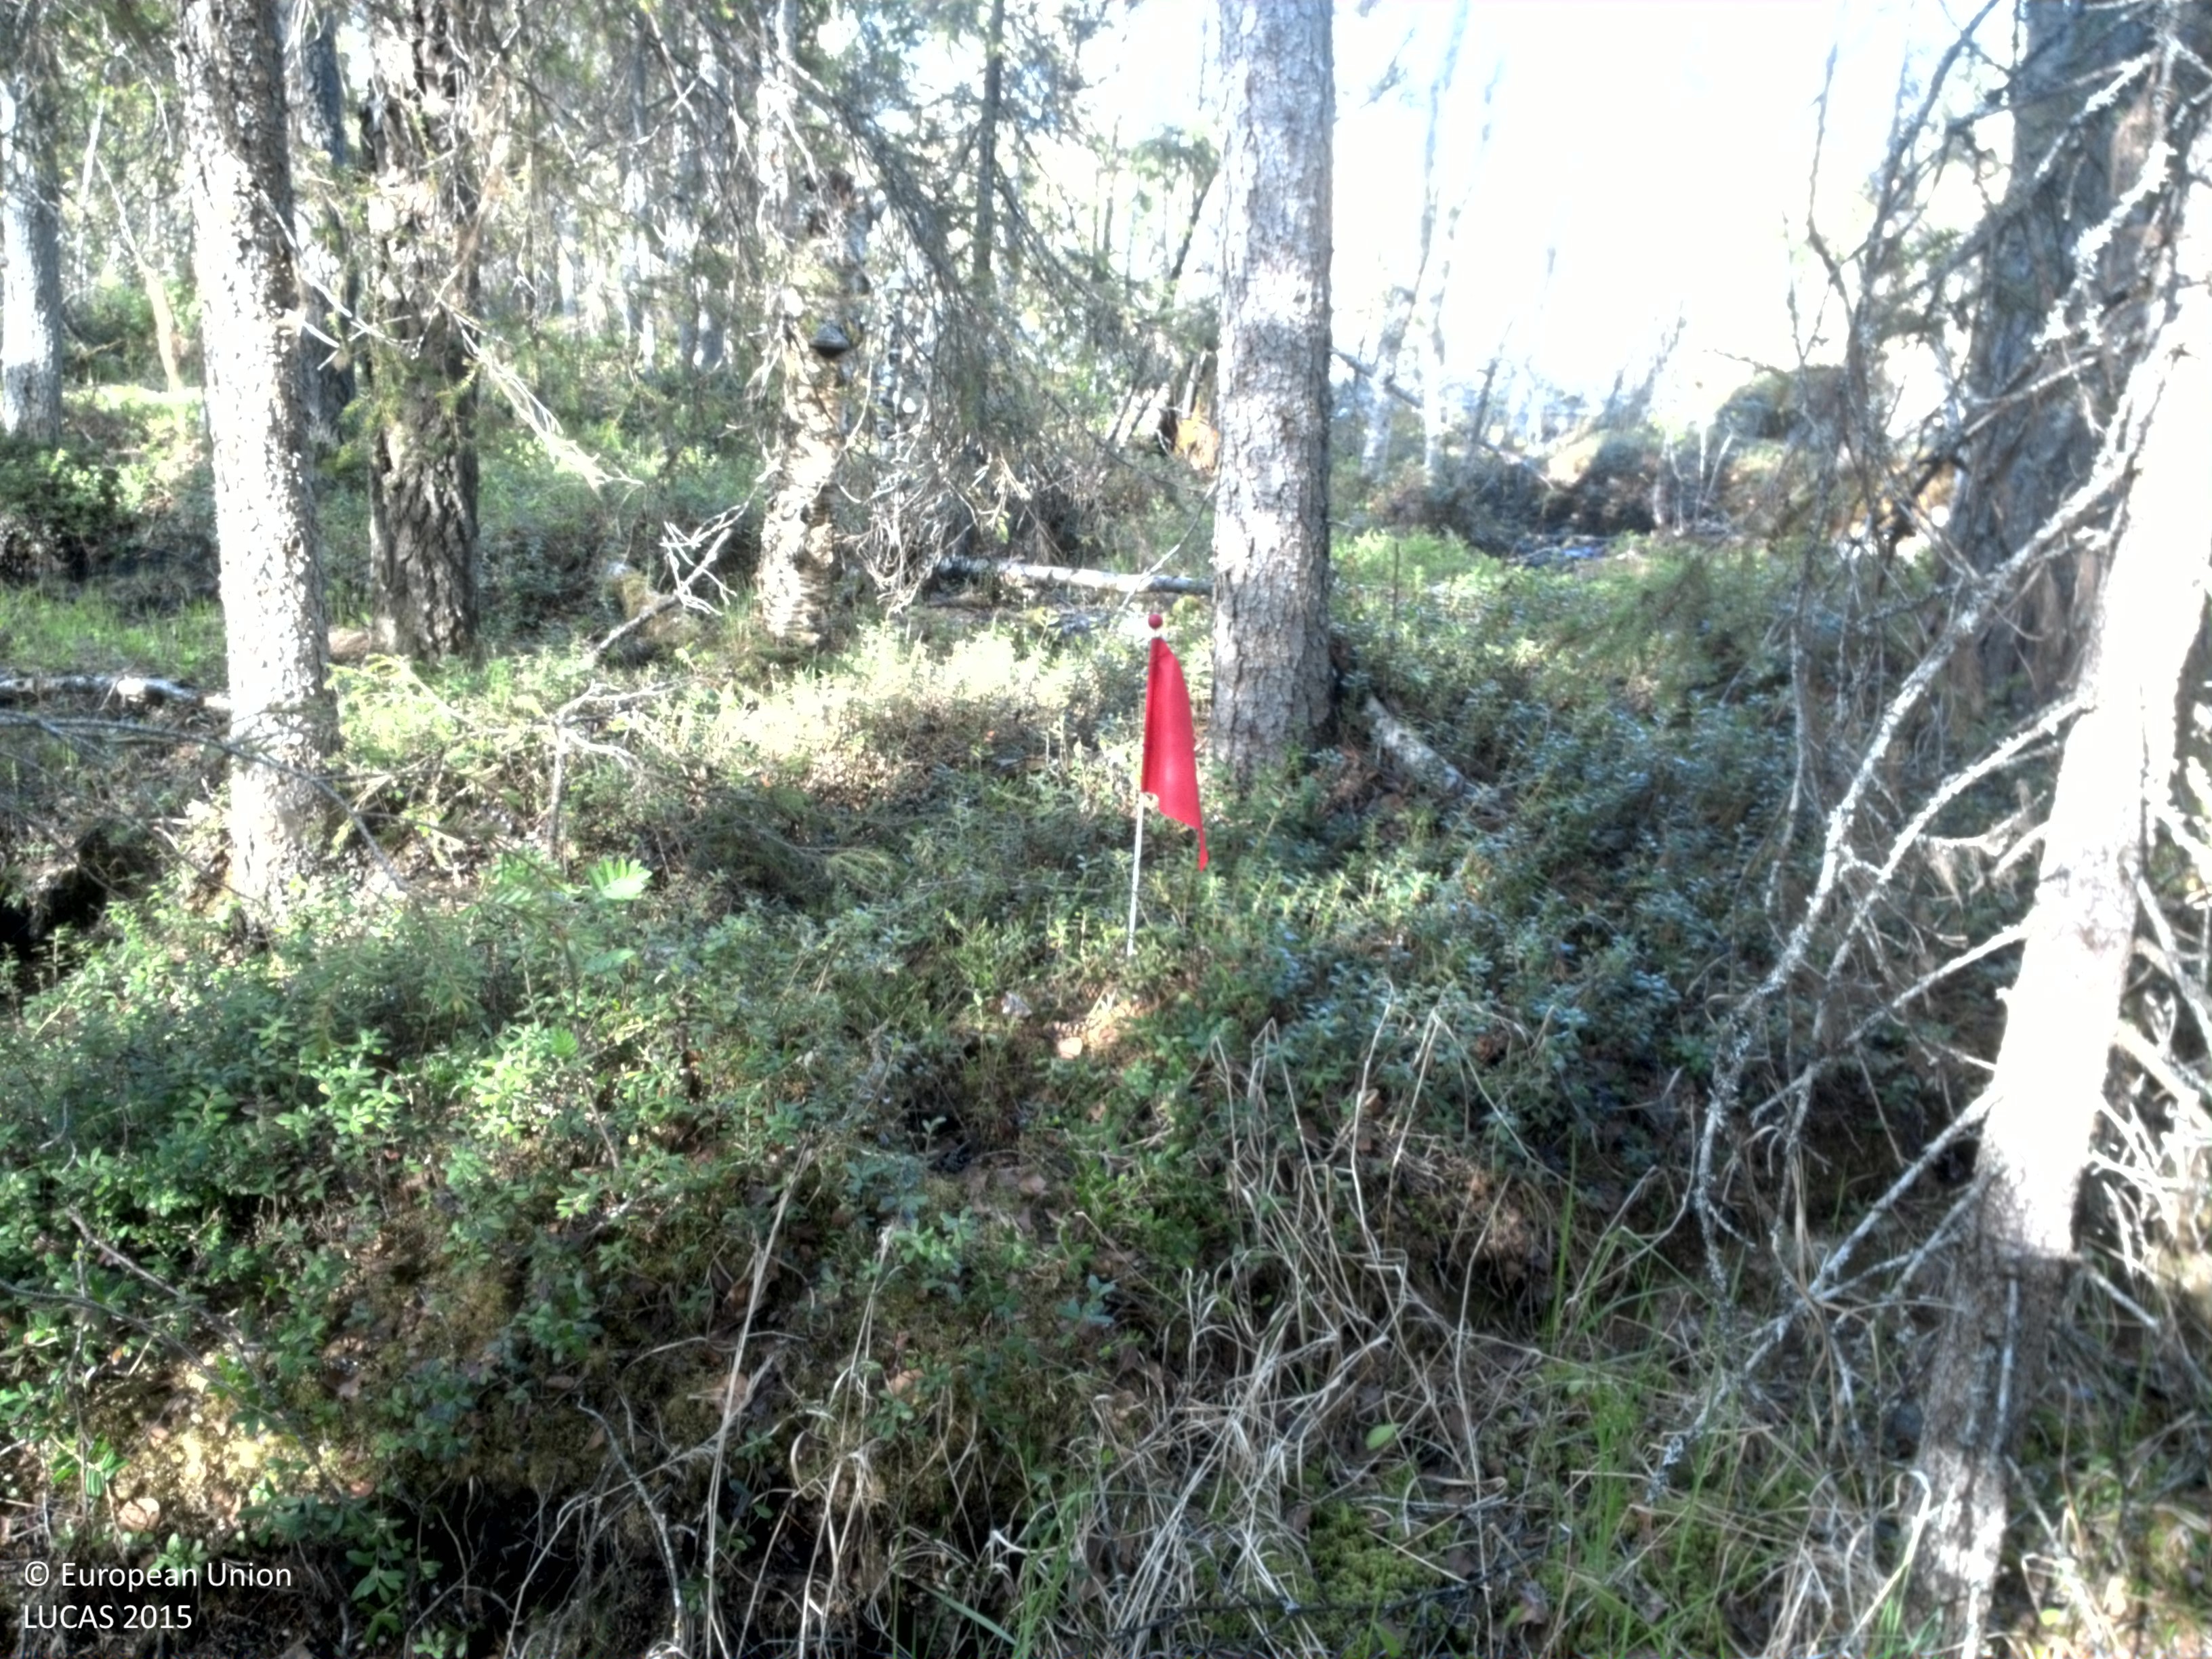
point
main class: Woodland
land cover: Spruce dominated mixed woodland
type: boreal forest
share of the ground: 25 - 50 %
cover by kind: herbaceous plants 45 %, coniferous forest trees 30 %, broadleaved forest trees 10 %, lichens and mosses 5 %
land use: Forestry
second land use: Amenities, museums, leisure
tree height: > 5 m
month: June
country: SE
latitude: 66.7012
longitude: 21.8578
